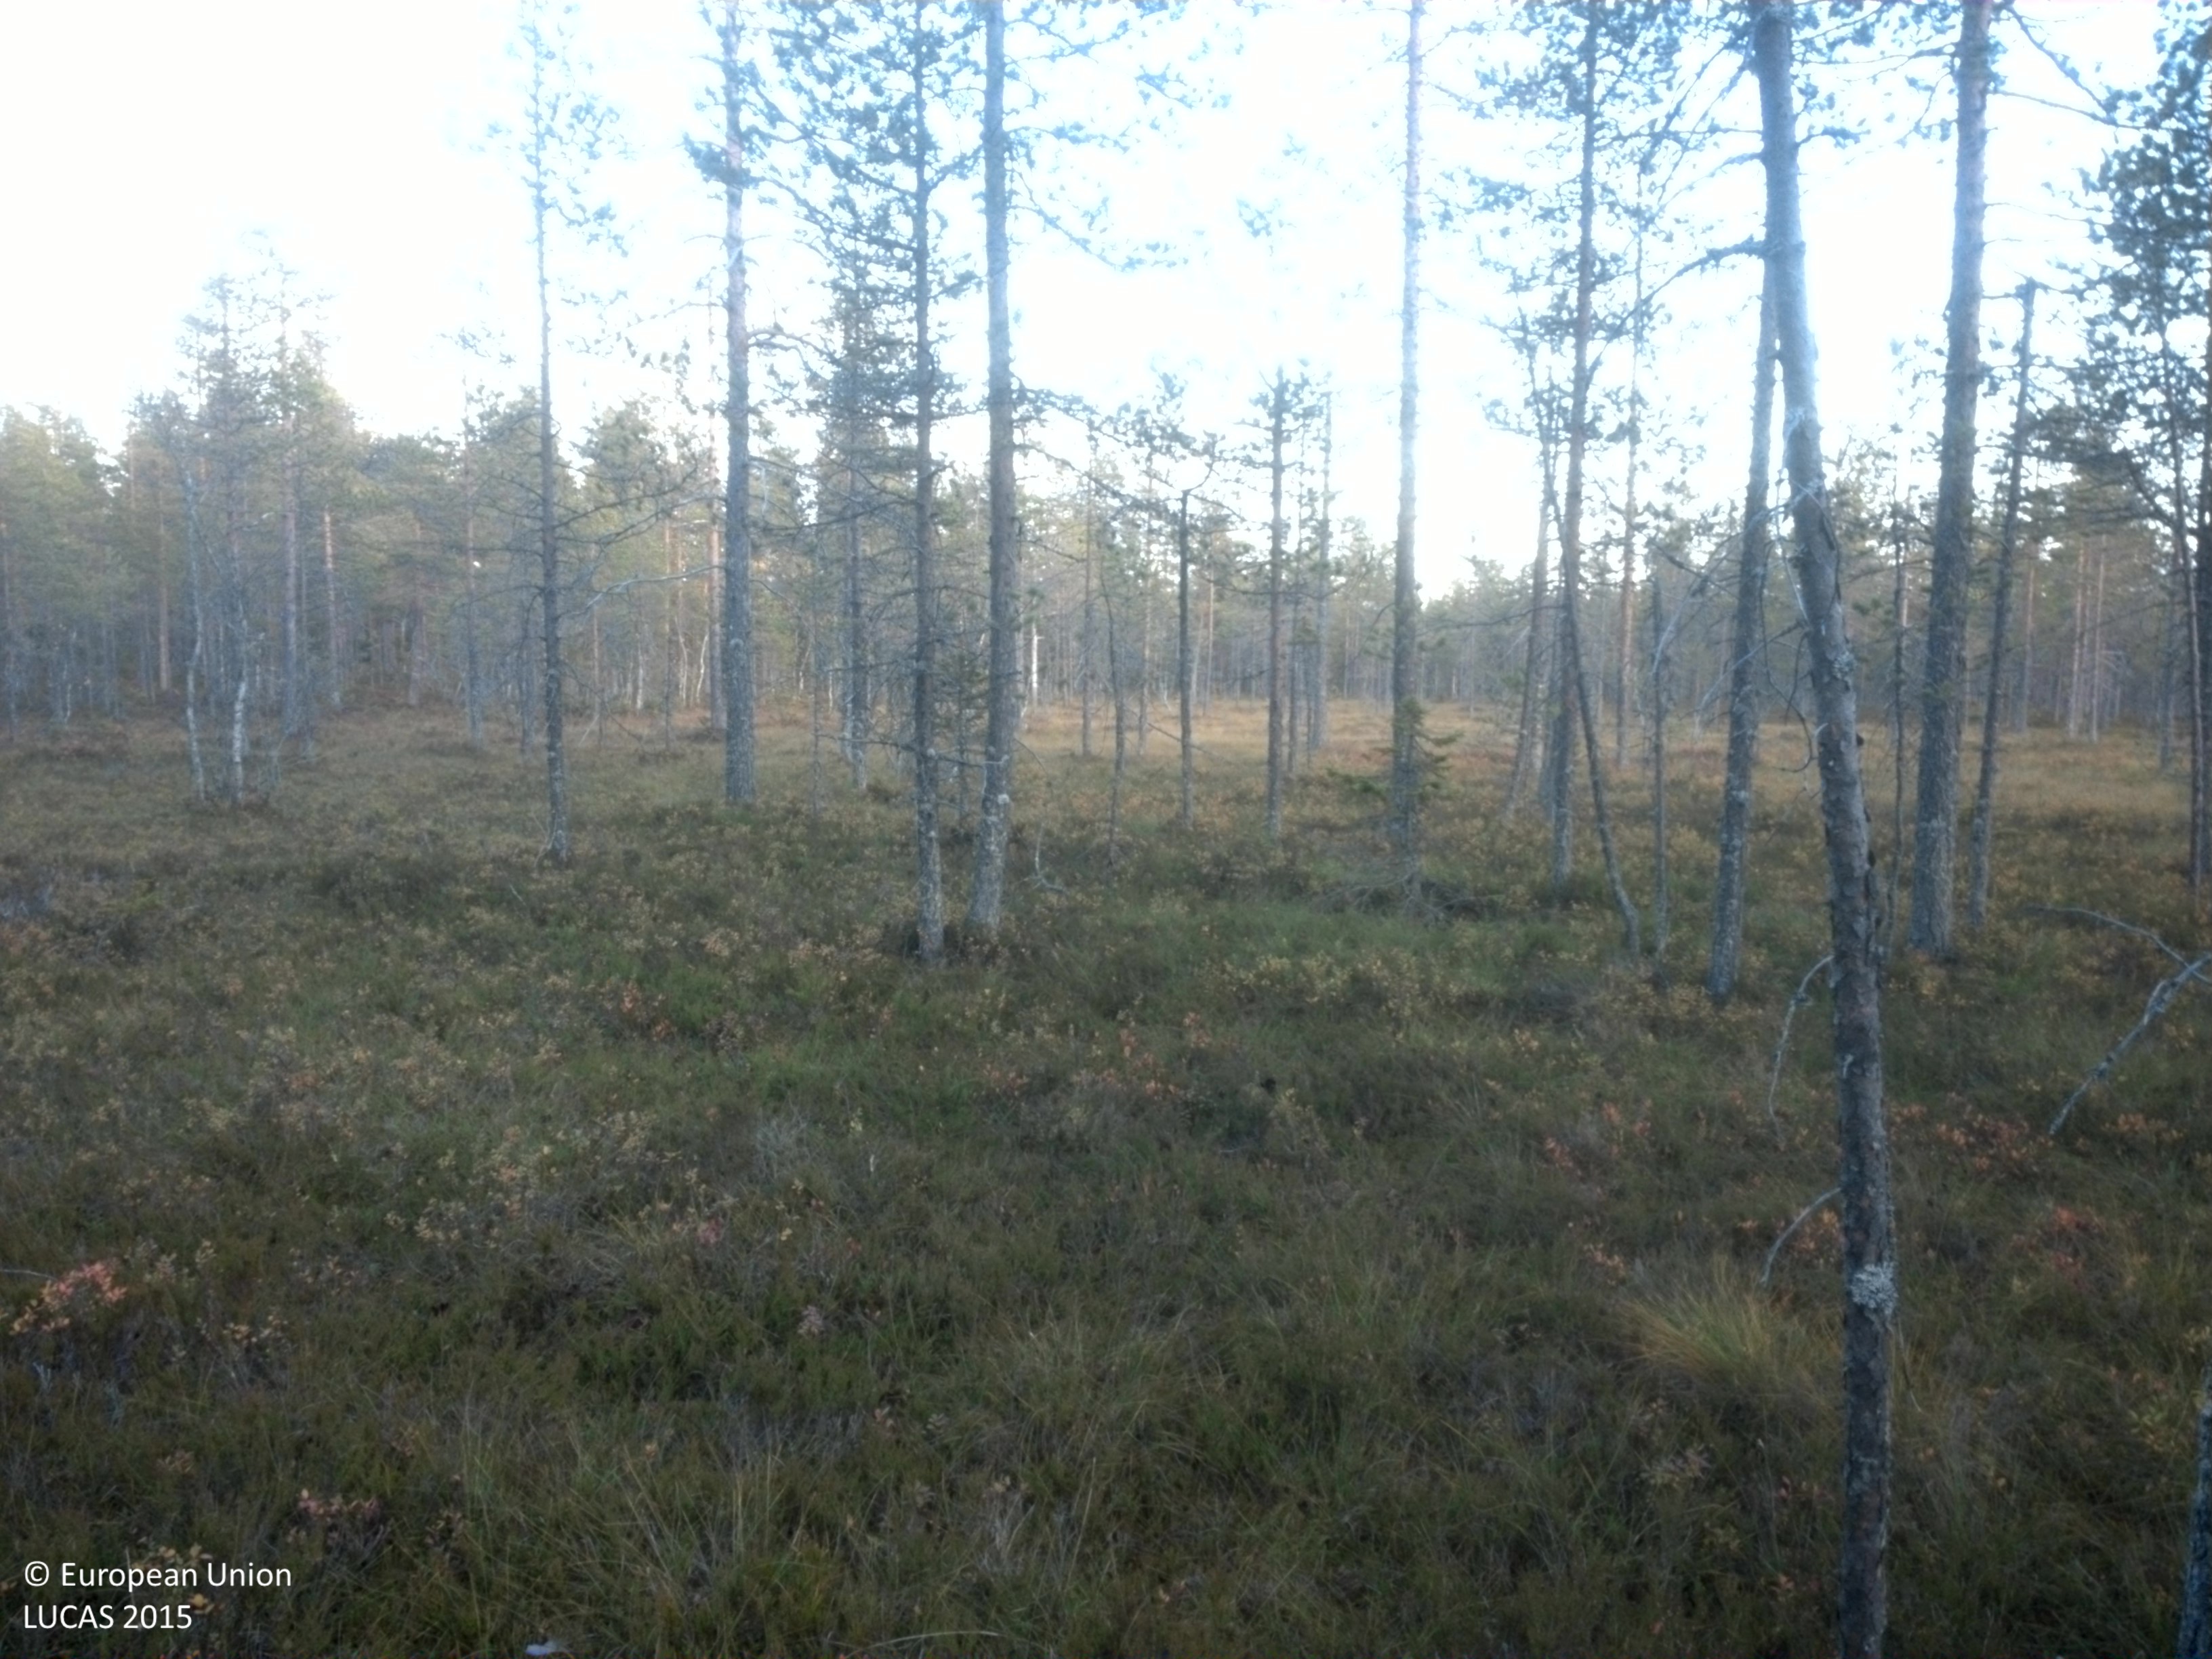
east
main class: Woodland
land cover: Pine dominated coniferous woodland
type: mire and swamp forests
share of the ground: 25 - 50 %
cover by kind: shrubs 40 %, coniferous forest trees 35 %, herbaceous plants 15 %, lichens and mosses 10 %
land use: Semi-natural and natural areas not in use
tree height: > 5 m
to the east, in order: Pine dominated coniferous woodland; Other coniferous woodland; Other mixed woodland; Electric lines; Other mixed woodland; Ditches and canals; Tracks; Shrubland with sparse tree cover; Other coniferous woodland
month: September
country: SE
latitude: 64.1833
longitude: 20.1240
